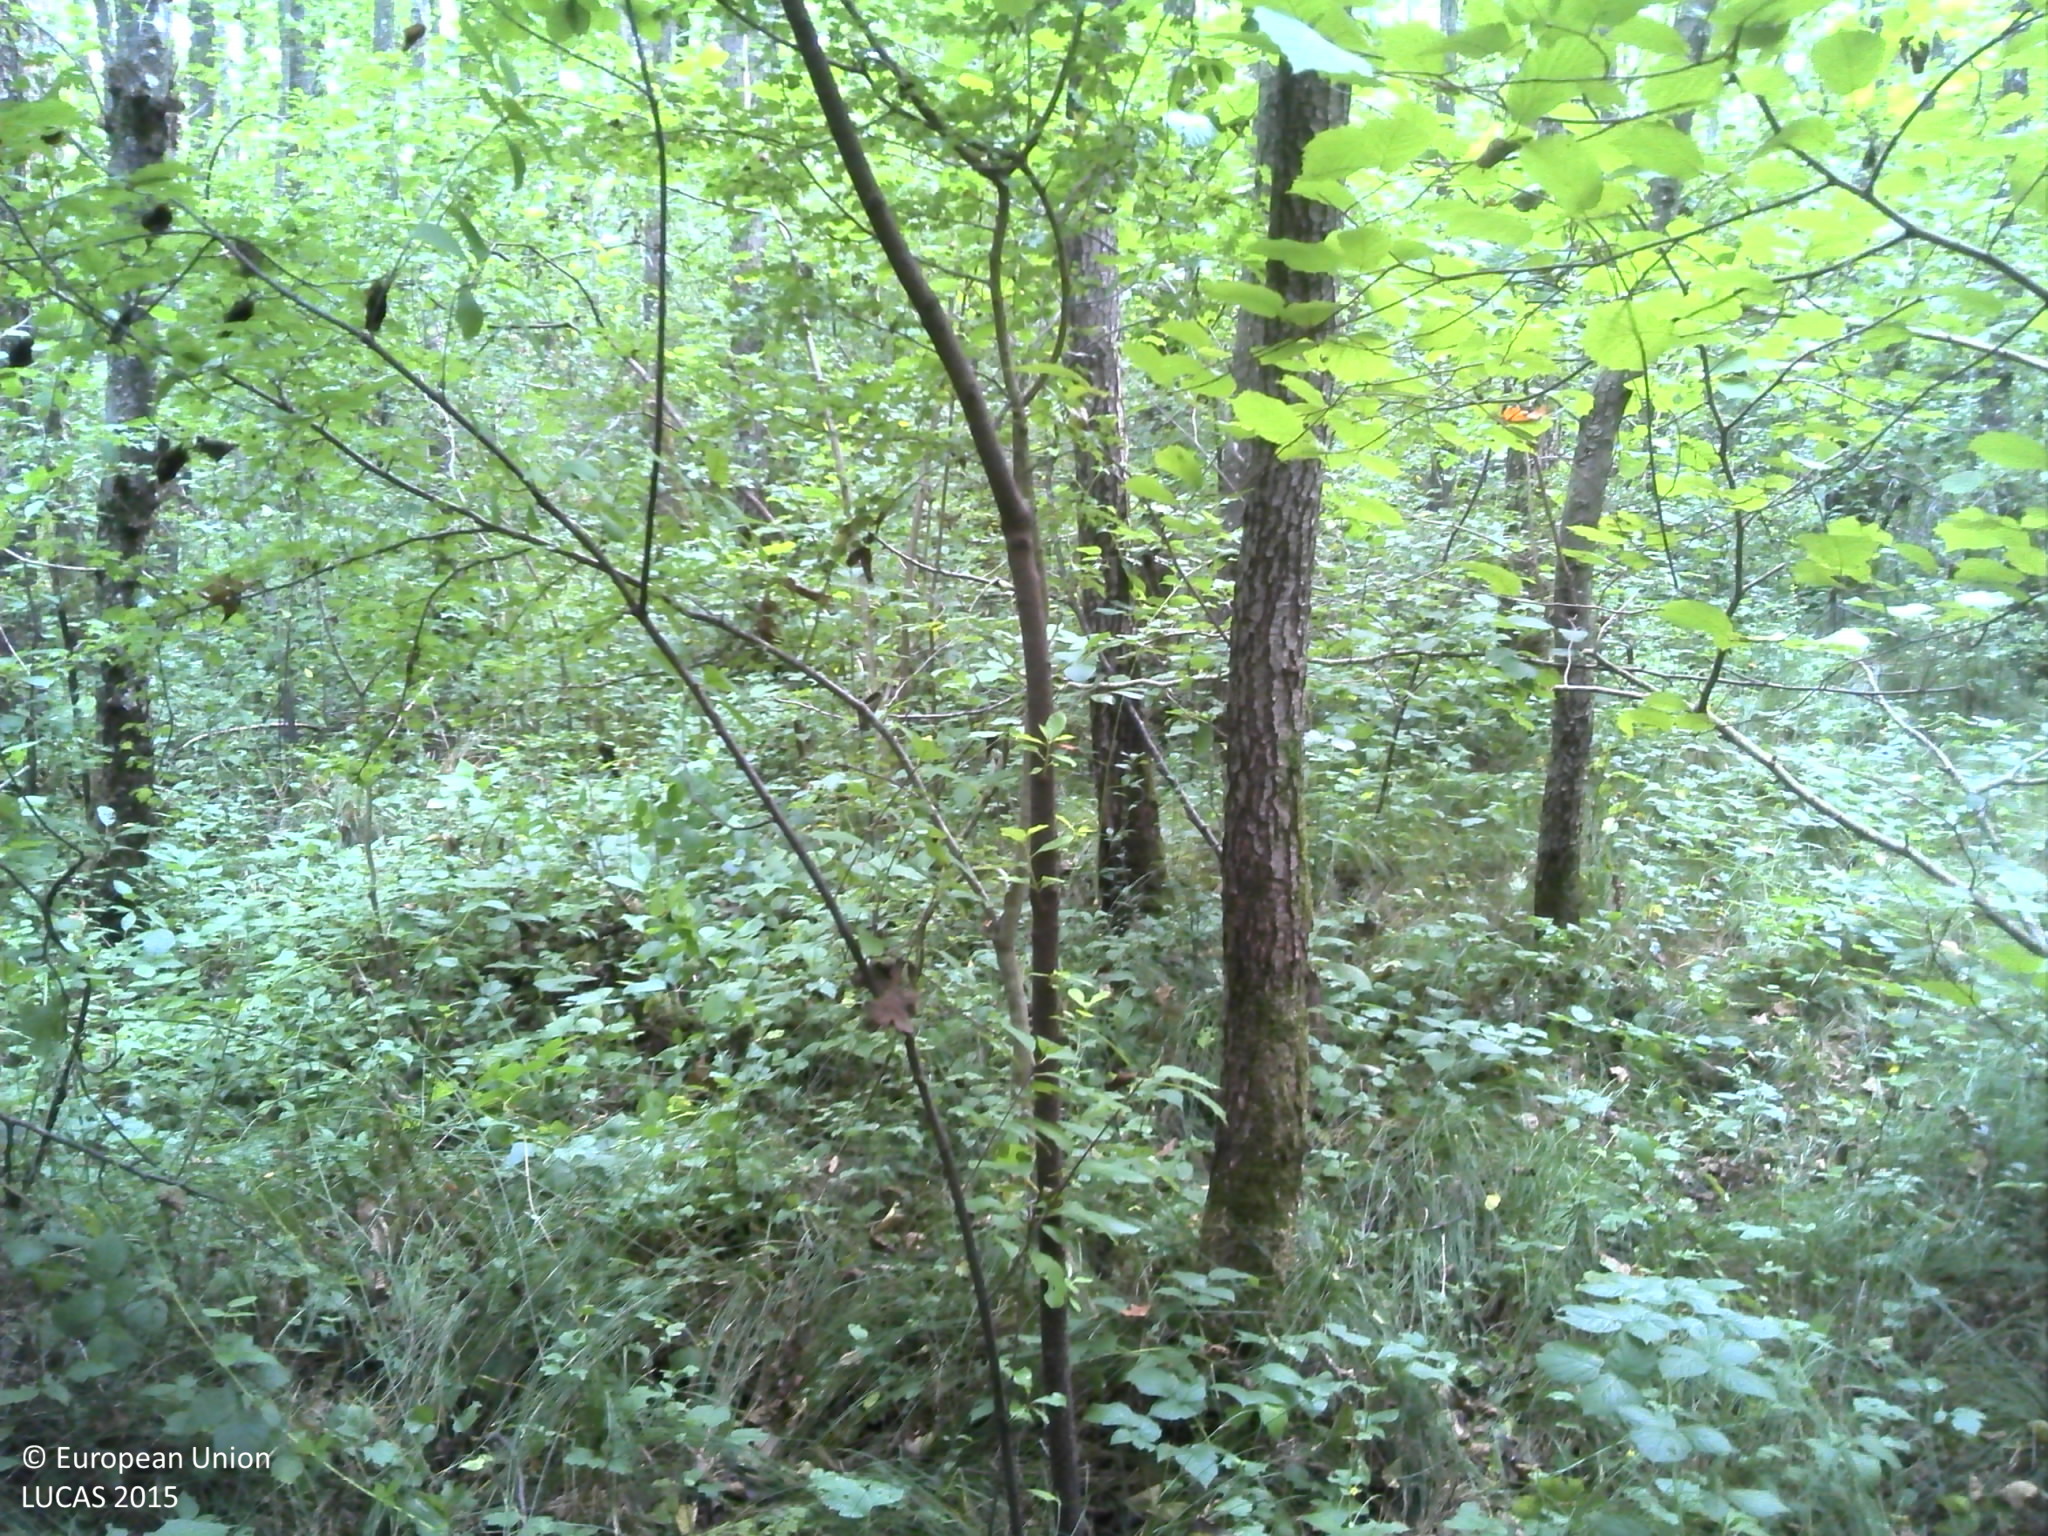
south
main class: Woodland
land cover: Broadleaved woodland
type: beech forest
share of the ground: > 75 %
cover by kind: broadleaved forest trees 100 %
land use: Forestry
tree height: > 5 m
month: August
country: HR
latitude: 45.4995
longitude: 15.6145
